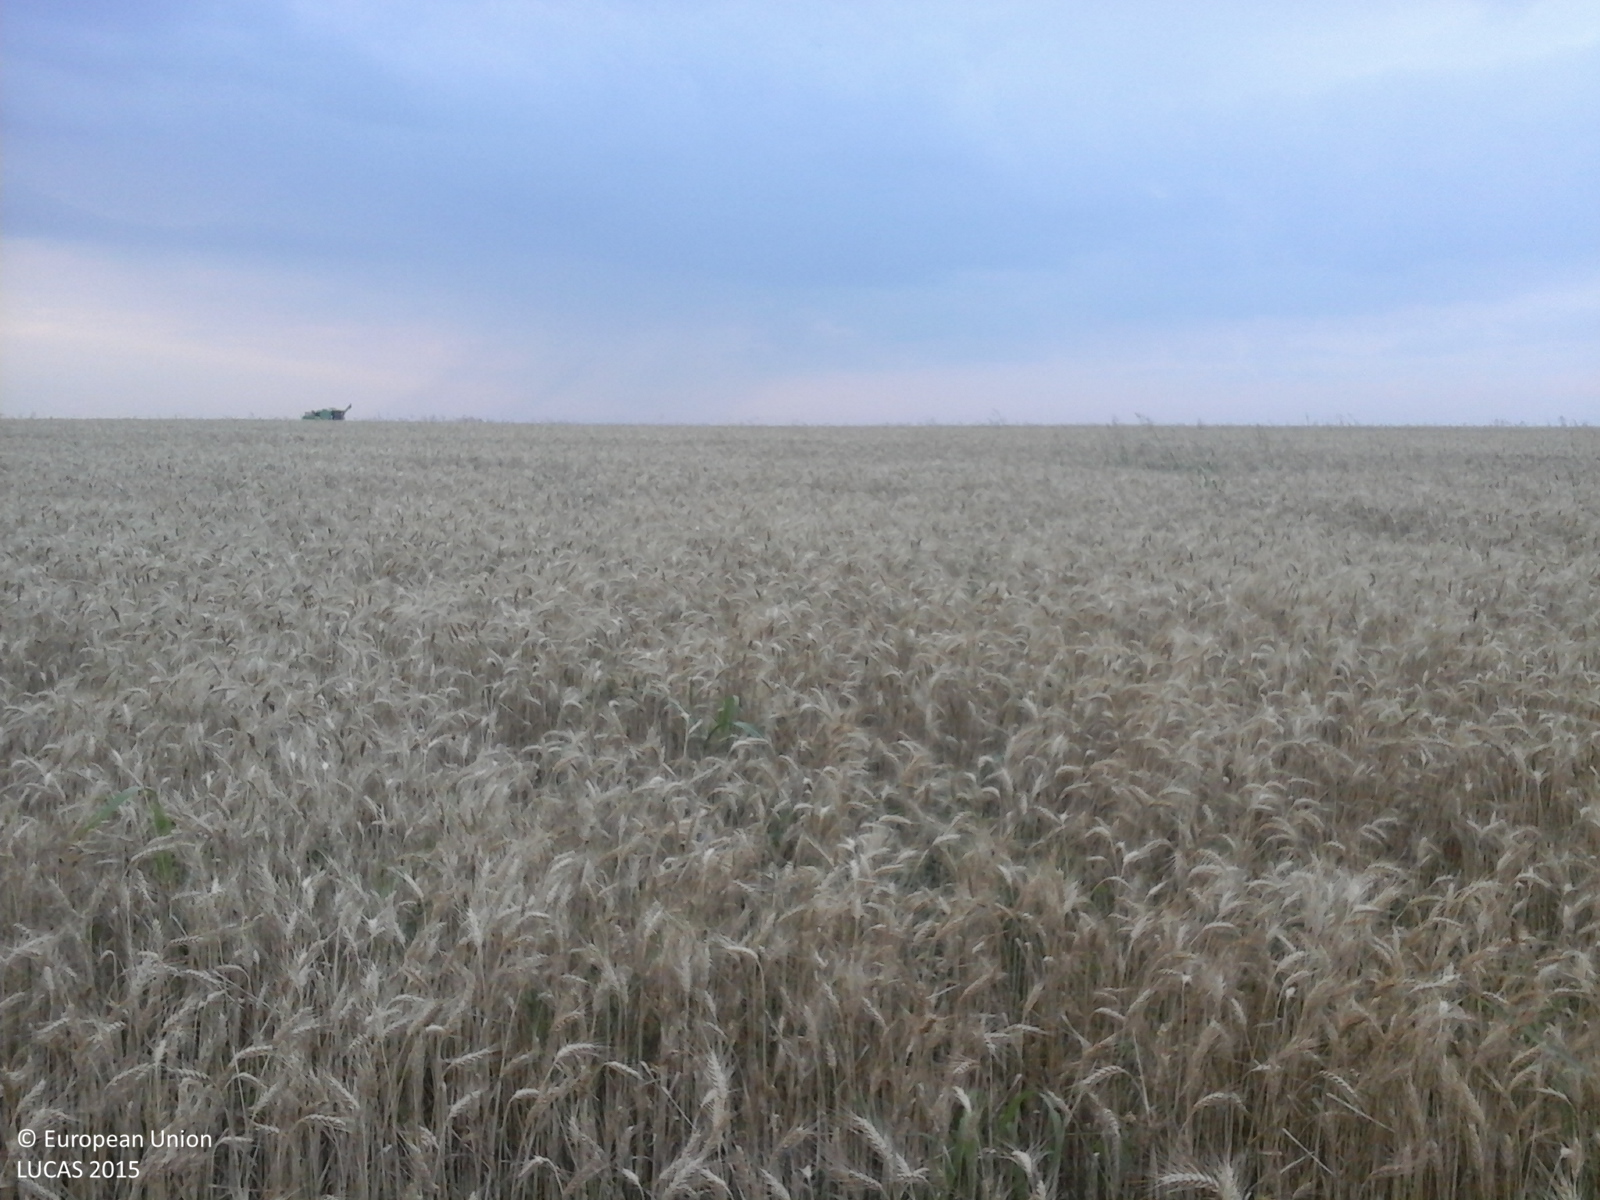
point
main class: Cropland
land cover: Common wheat
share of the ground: > 75 %
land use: Agriculture (excluding fallow land and kitchen gardens)
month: July
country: RO
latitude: 43.9825
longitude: 24.7704
